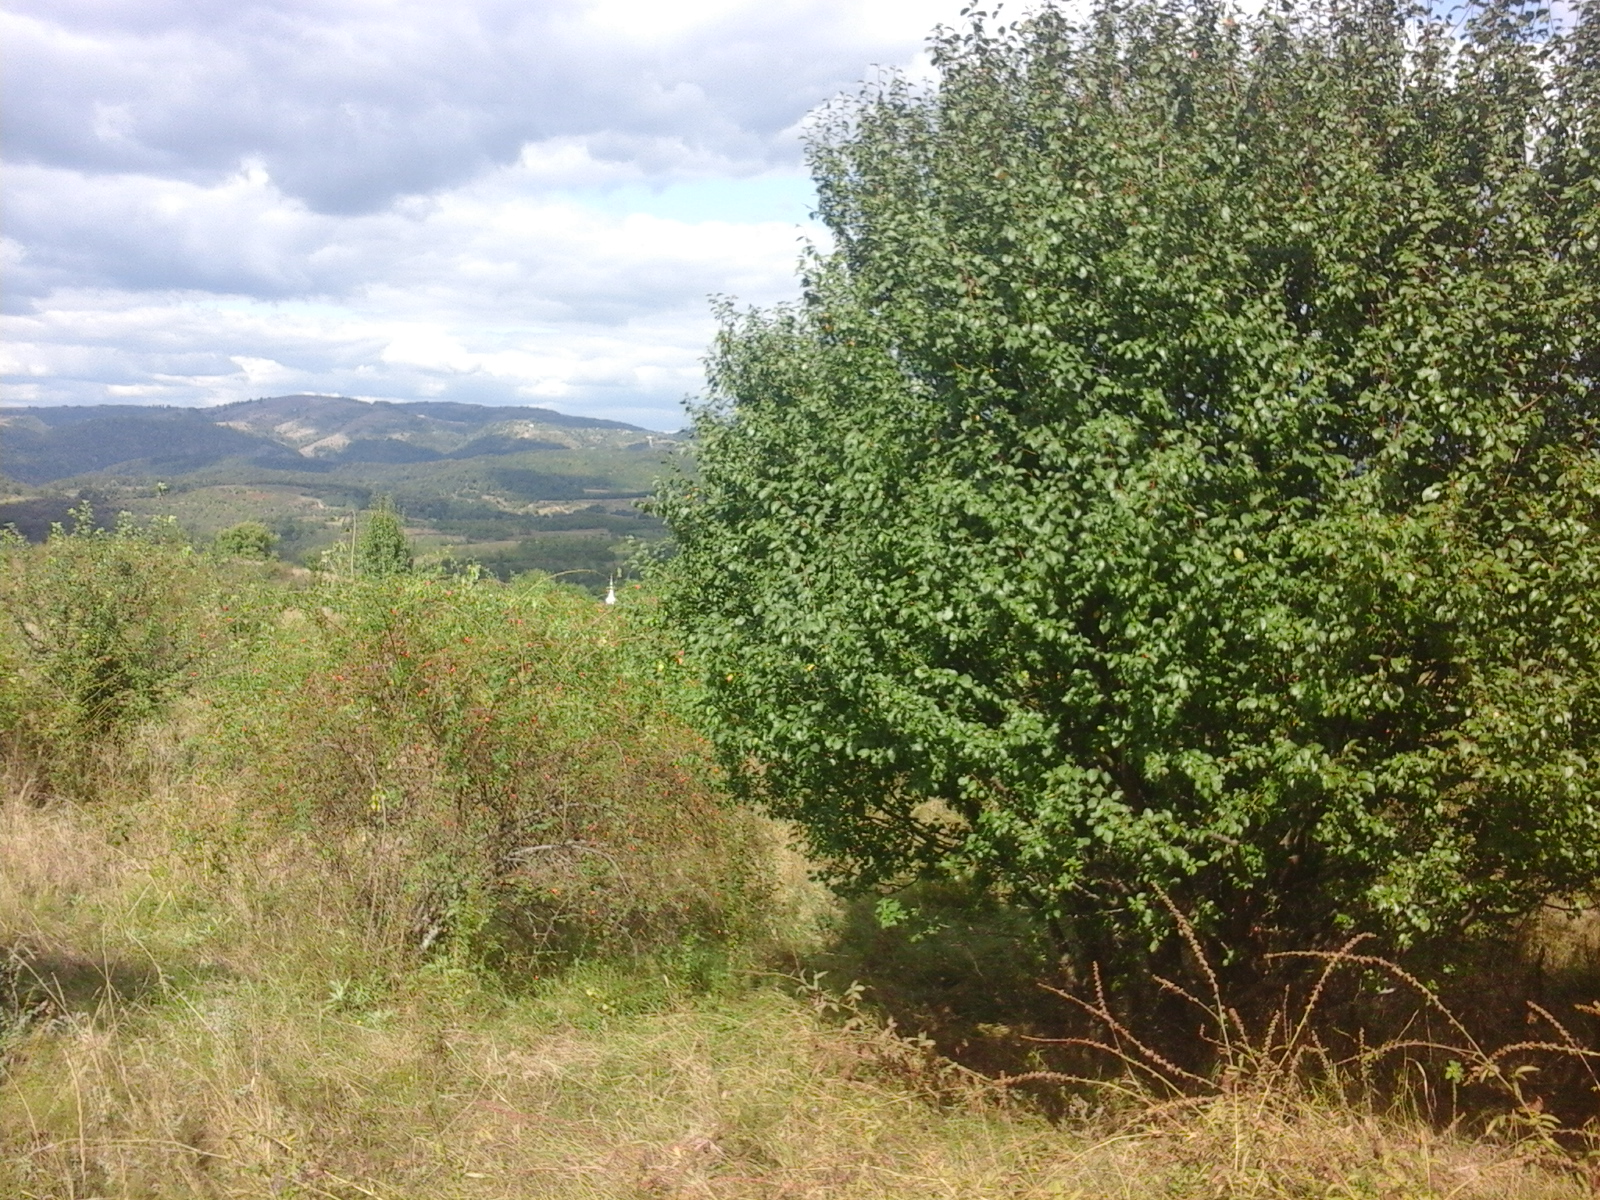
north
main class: Grassland
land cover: Grassland with sparse tree/shrub cover
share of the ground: > 75 %
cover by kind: herbaceous plants 85 %, shrubs 10 %, broadleaved forest trees 5 %
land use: Fallow land
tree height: < 5 m
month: September
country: RO
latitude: 47.3983
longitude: 23.7110
